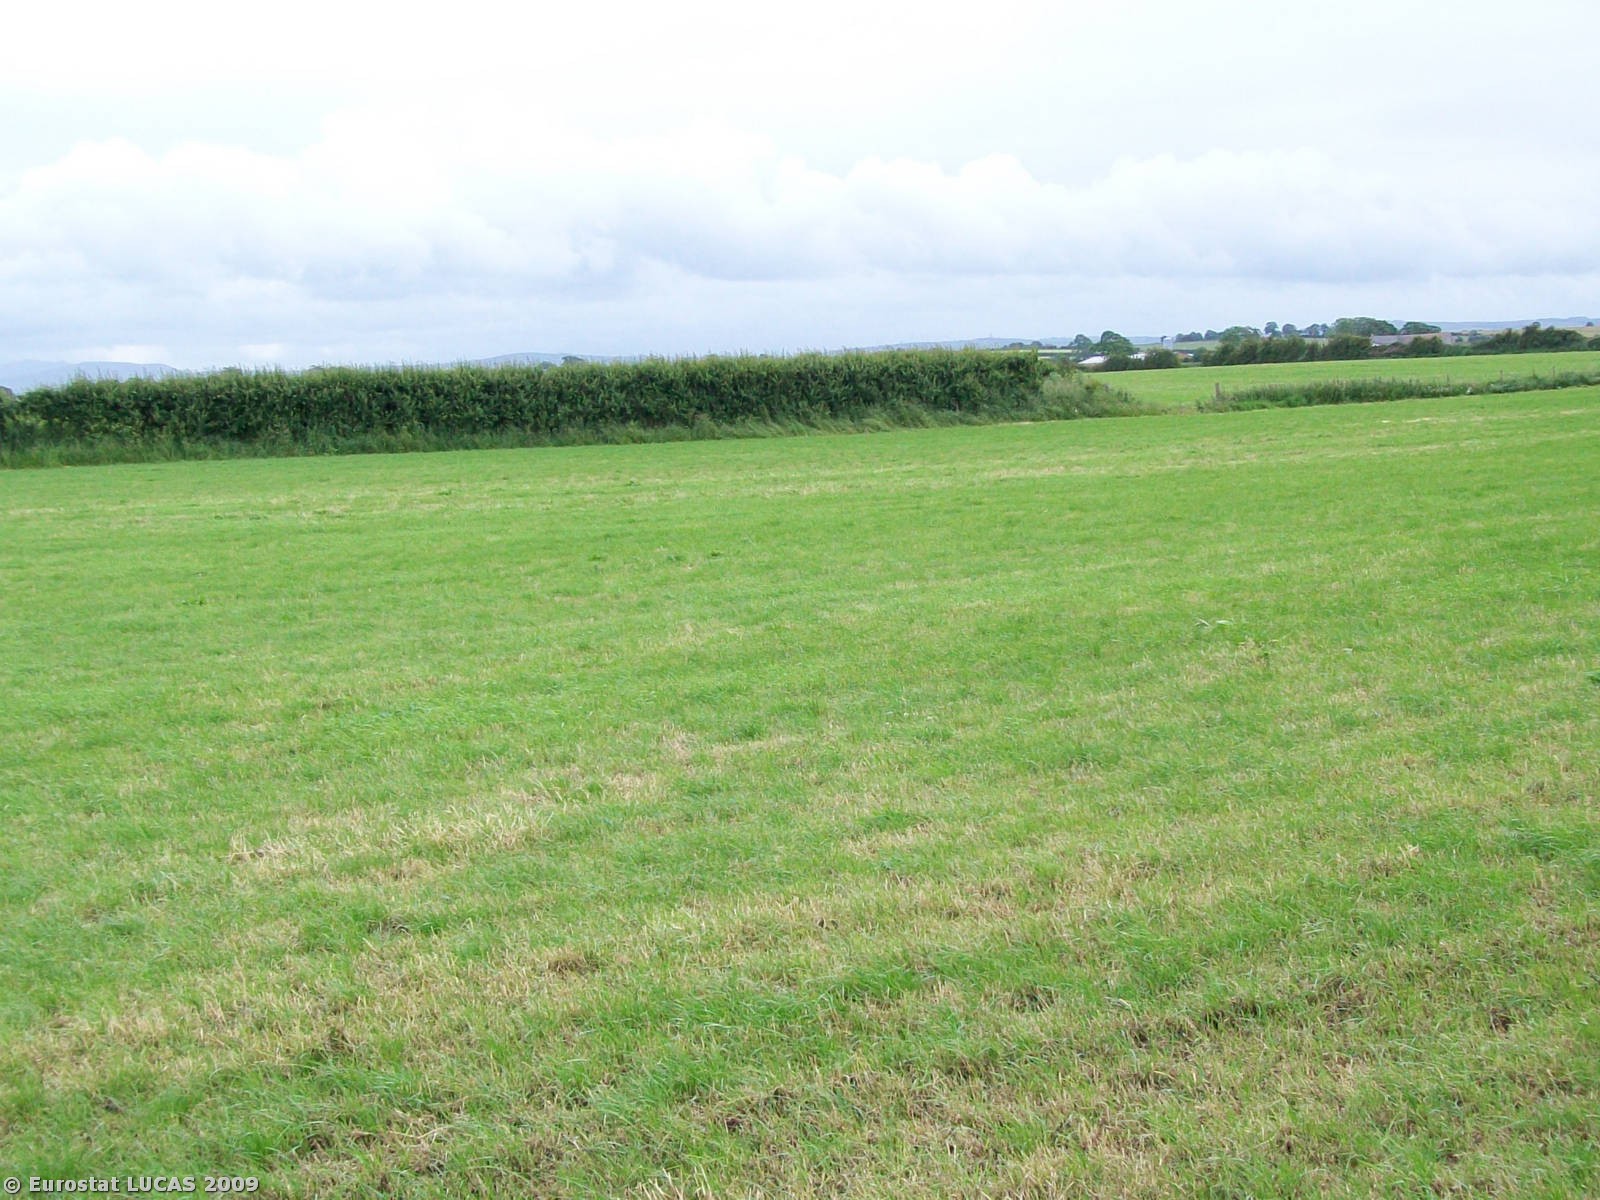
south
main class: Cropland
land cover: Temporary grasslands
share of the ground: > 75 %
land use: Agriculture (excluding fallow land and kitchen gardens)
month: June
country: GB
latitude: 54.8382
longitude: -3.2646
